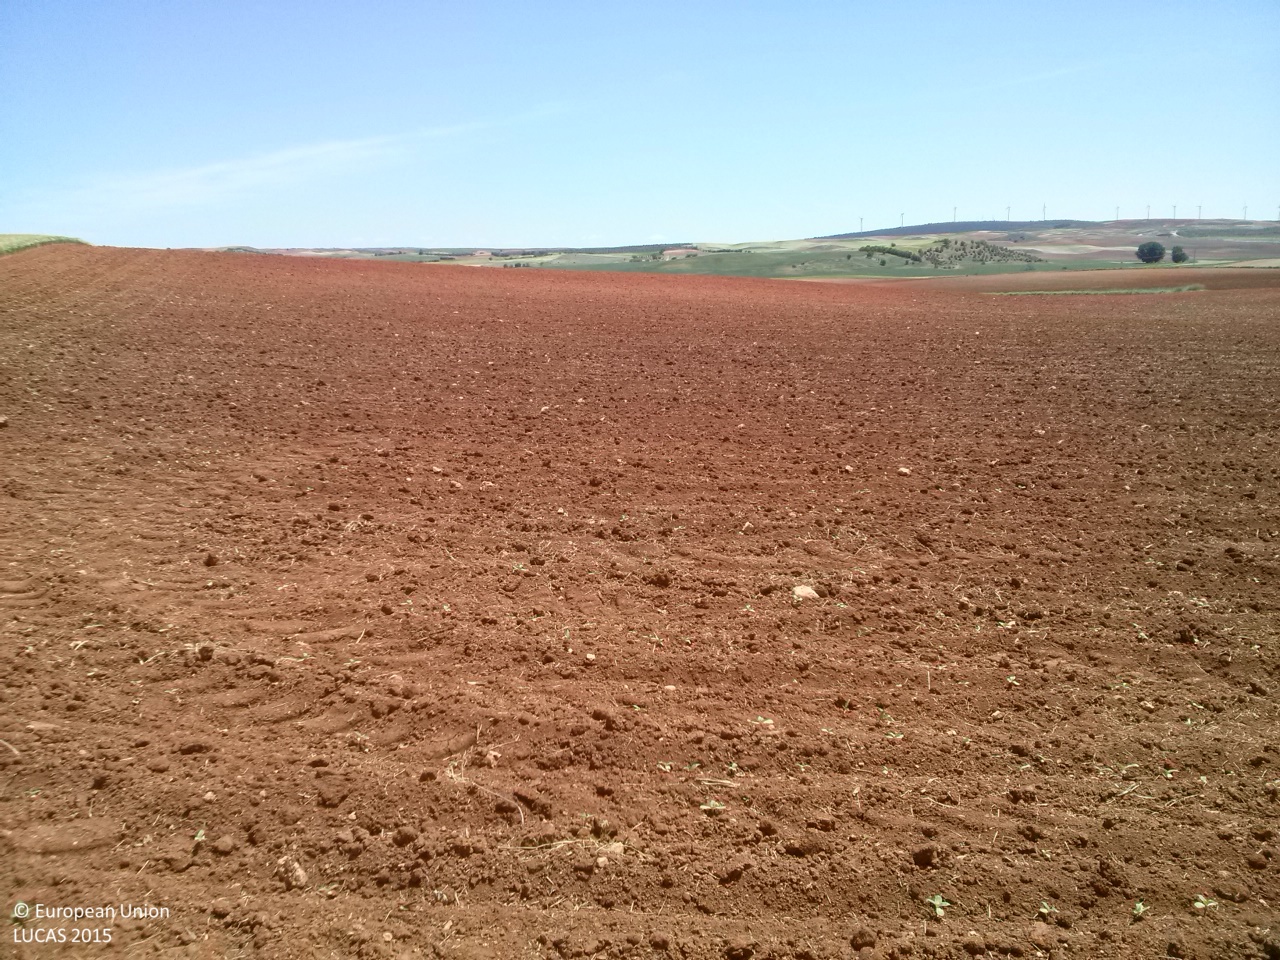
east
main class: Cropland
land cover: Sunflower
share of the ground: < 10 %
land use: Agriculture (excluding fallow land and kitchen gardens)
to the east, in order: Sunflower
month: May
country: ES
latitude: 40.0428
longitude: -2.8329
